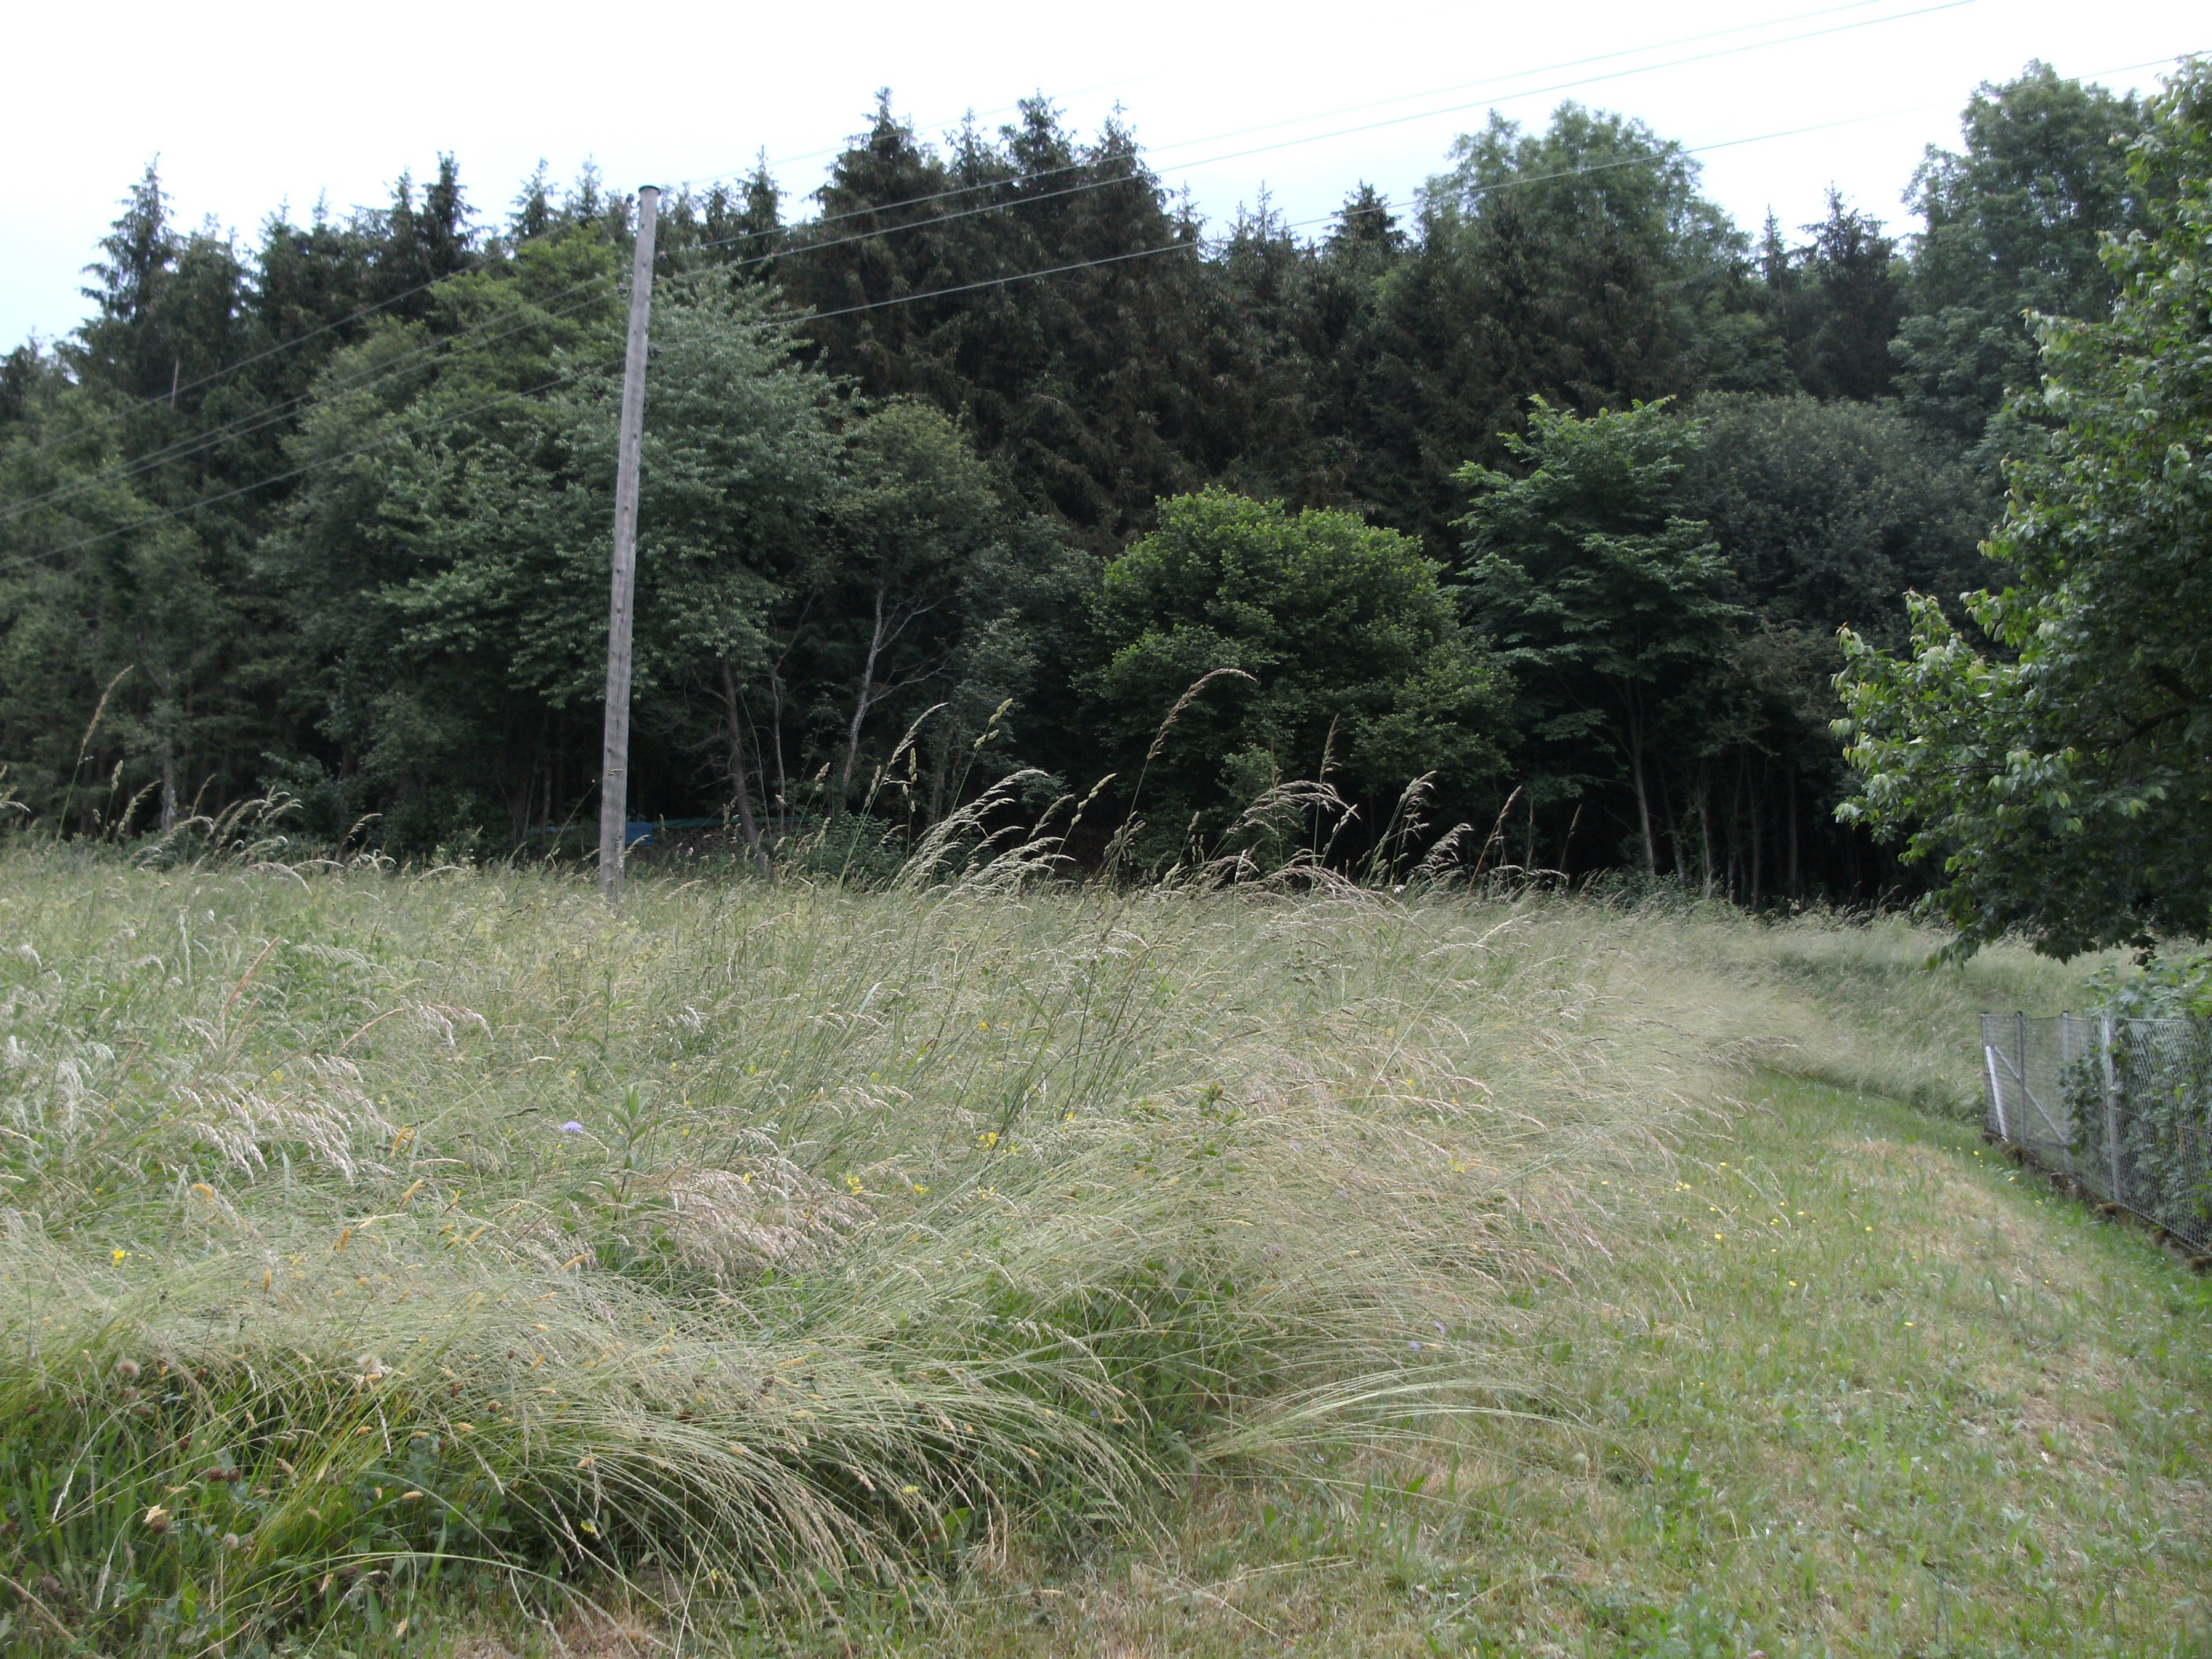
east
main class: Grassland
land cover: Grassland without tree/shrub cover
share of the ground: > 75 %
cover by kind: herbaceous plants 100 %
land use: Agriculture (excluding fallow land and kitchen gardens)
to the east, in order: Grassland without tree/shrub cover; Electric lines; Grassland without tree/shrub cover; Broadleaved woodland; Tracks; Spruce dominated mixed woodland; Tracks; Spruce dominated coniferous woodland; Tracks; Spruce dominated coniferous woodland; Tracks; Spruce dominated coniferous woodland; Grassland without tree/shrub cover; Temporary grasslands
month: June
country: AT
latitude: 48.5814
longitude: 14.0532
